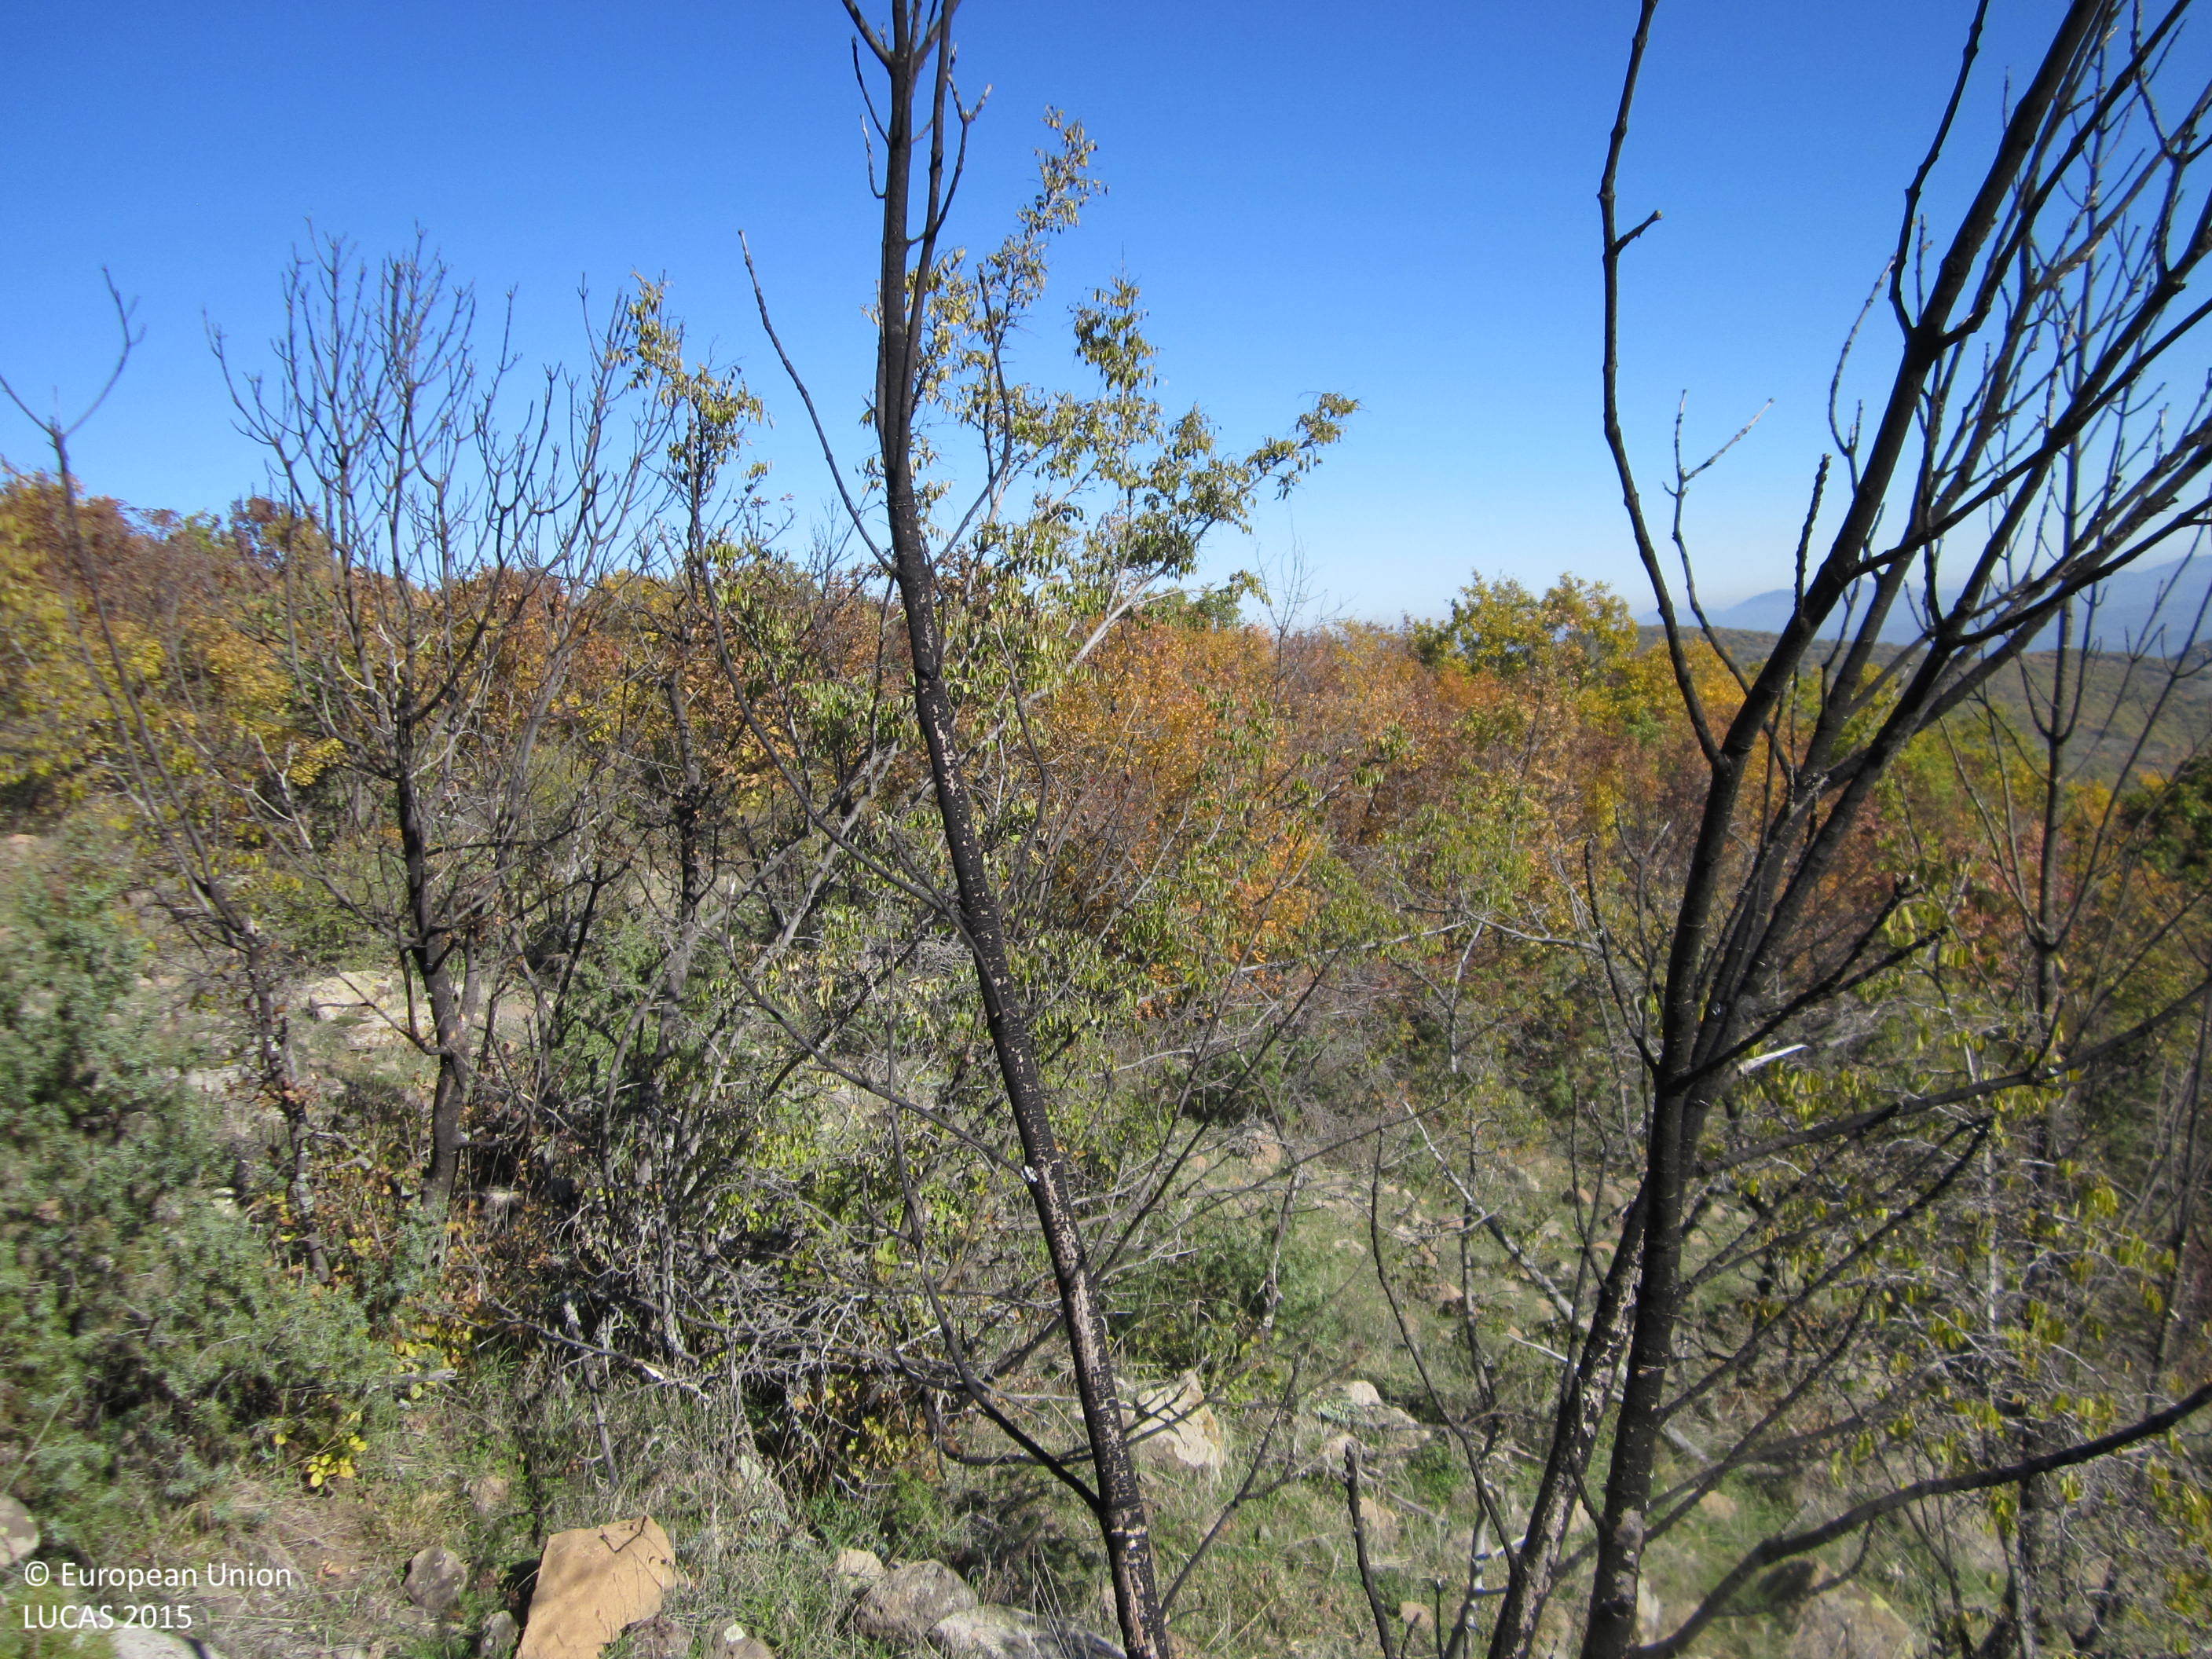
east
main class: Woodland
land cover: Broadleaved woodland
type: mesophytic deciduous forest
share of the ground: > 75 %
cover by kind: broadleaved forest trees 100 %
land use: Forestry
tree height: > 5 m
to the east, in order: Broadleaved woodland; Tracks; Broadleaved woodland
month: November
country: BG
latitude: 41.5845
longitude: 25.5941
